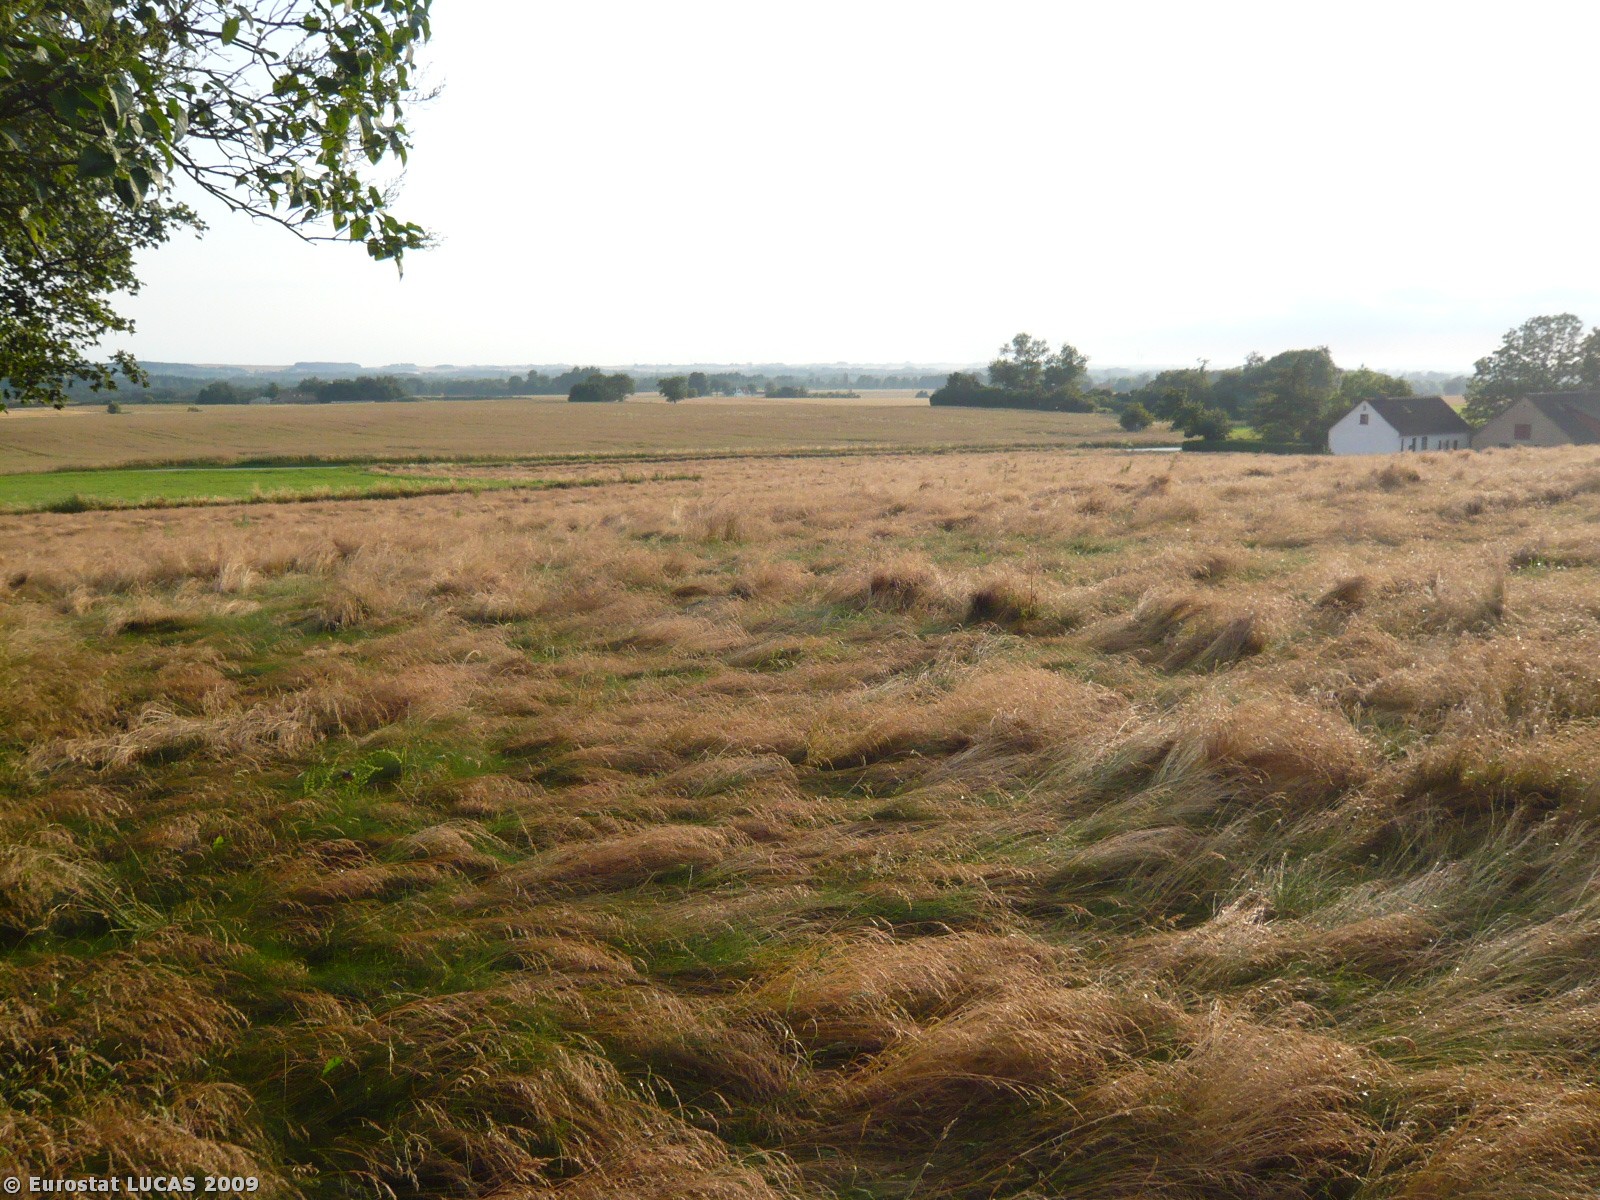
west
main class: Cropland
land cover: Temporary grasslands
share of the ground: > 75 %
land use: Agriculture (excluding fallow land and kitchen gardens)
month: July
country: DK
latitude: 55.6773
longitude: 11.3504
